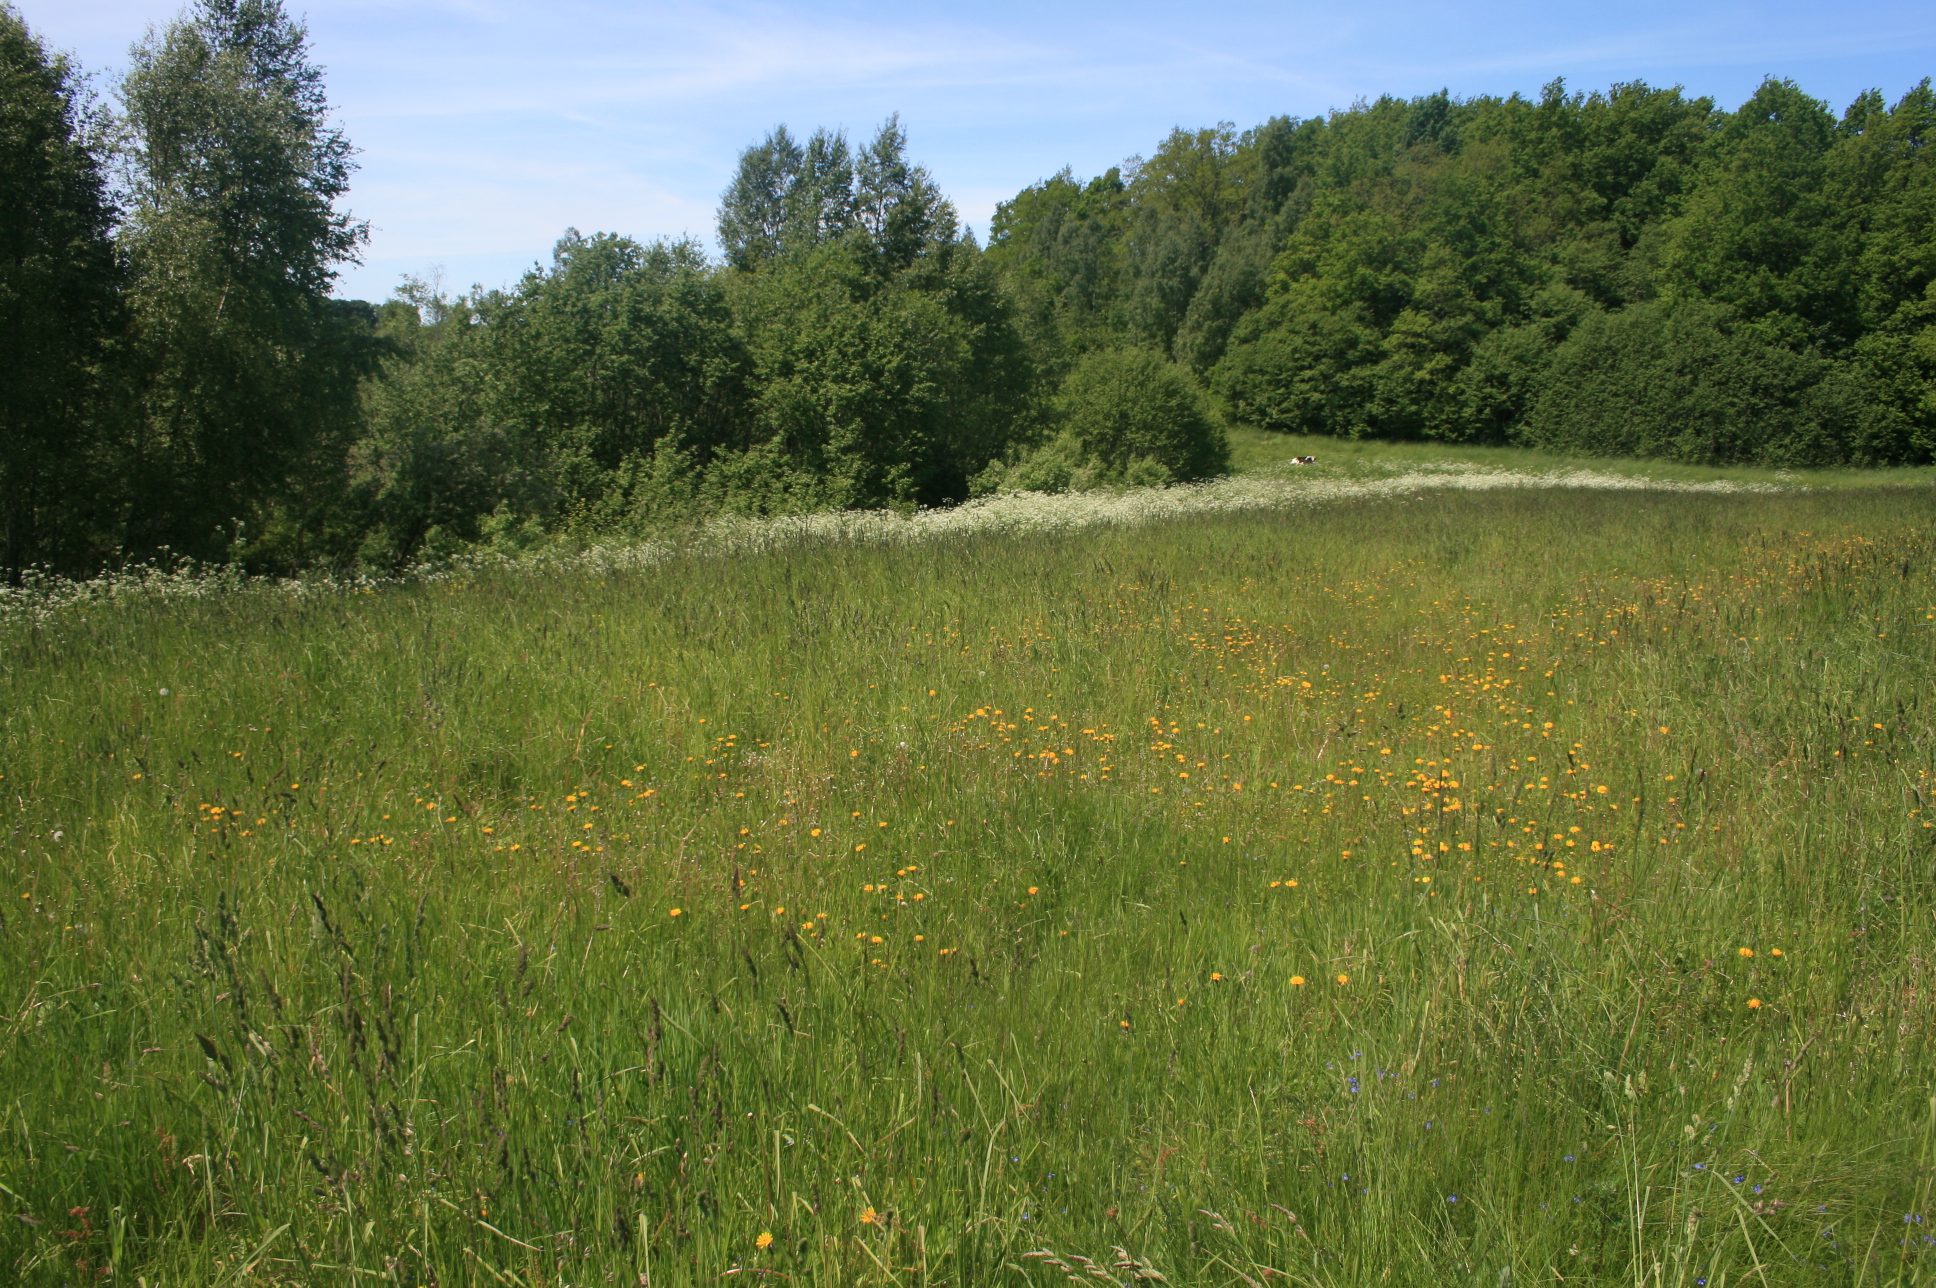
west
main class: Grassland
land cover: Grassland without tree/shrub cover
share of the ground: > 75 %
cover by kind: herbaceous plants 100 %
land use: Agriculture (excluding fallow land and kitchen gardens)
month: June
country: LT
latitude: 55.9005
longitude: 22.3238
